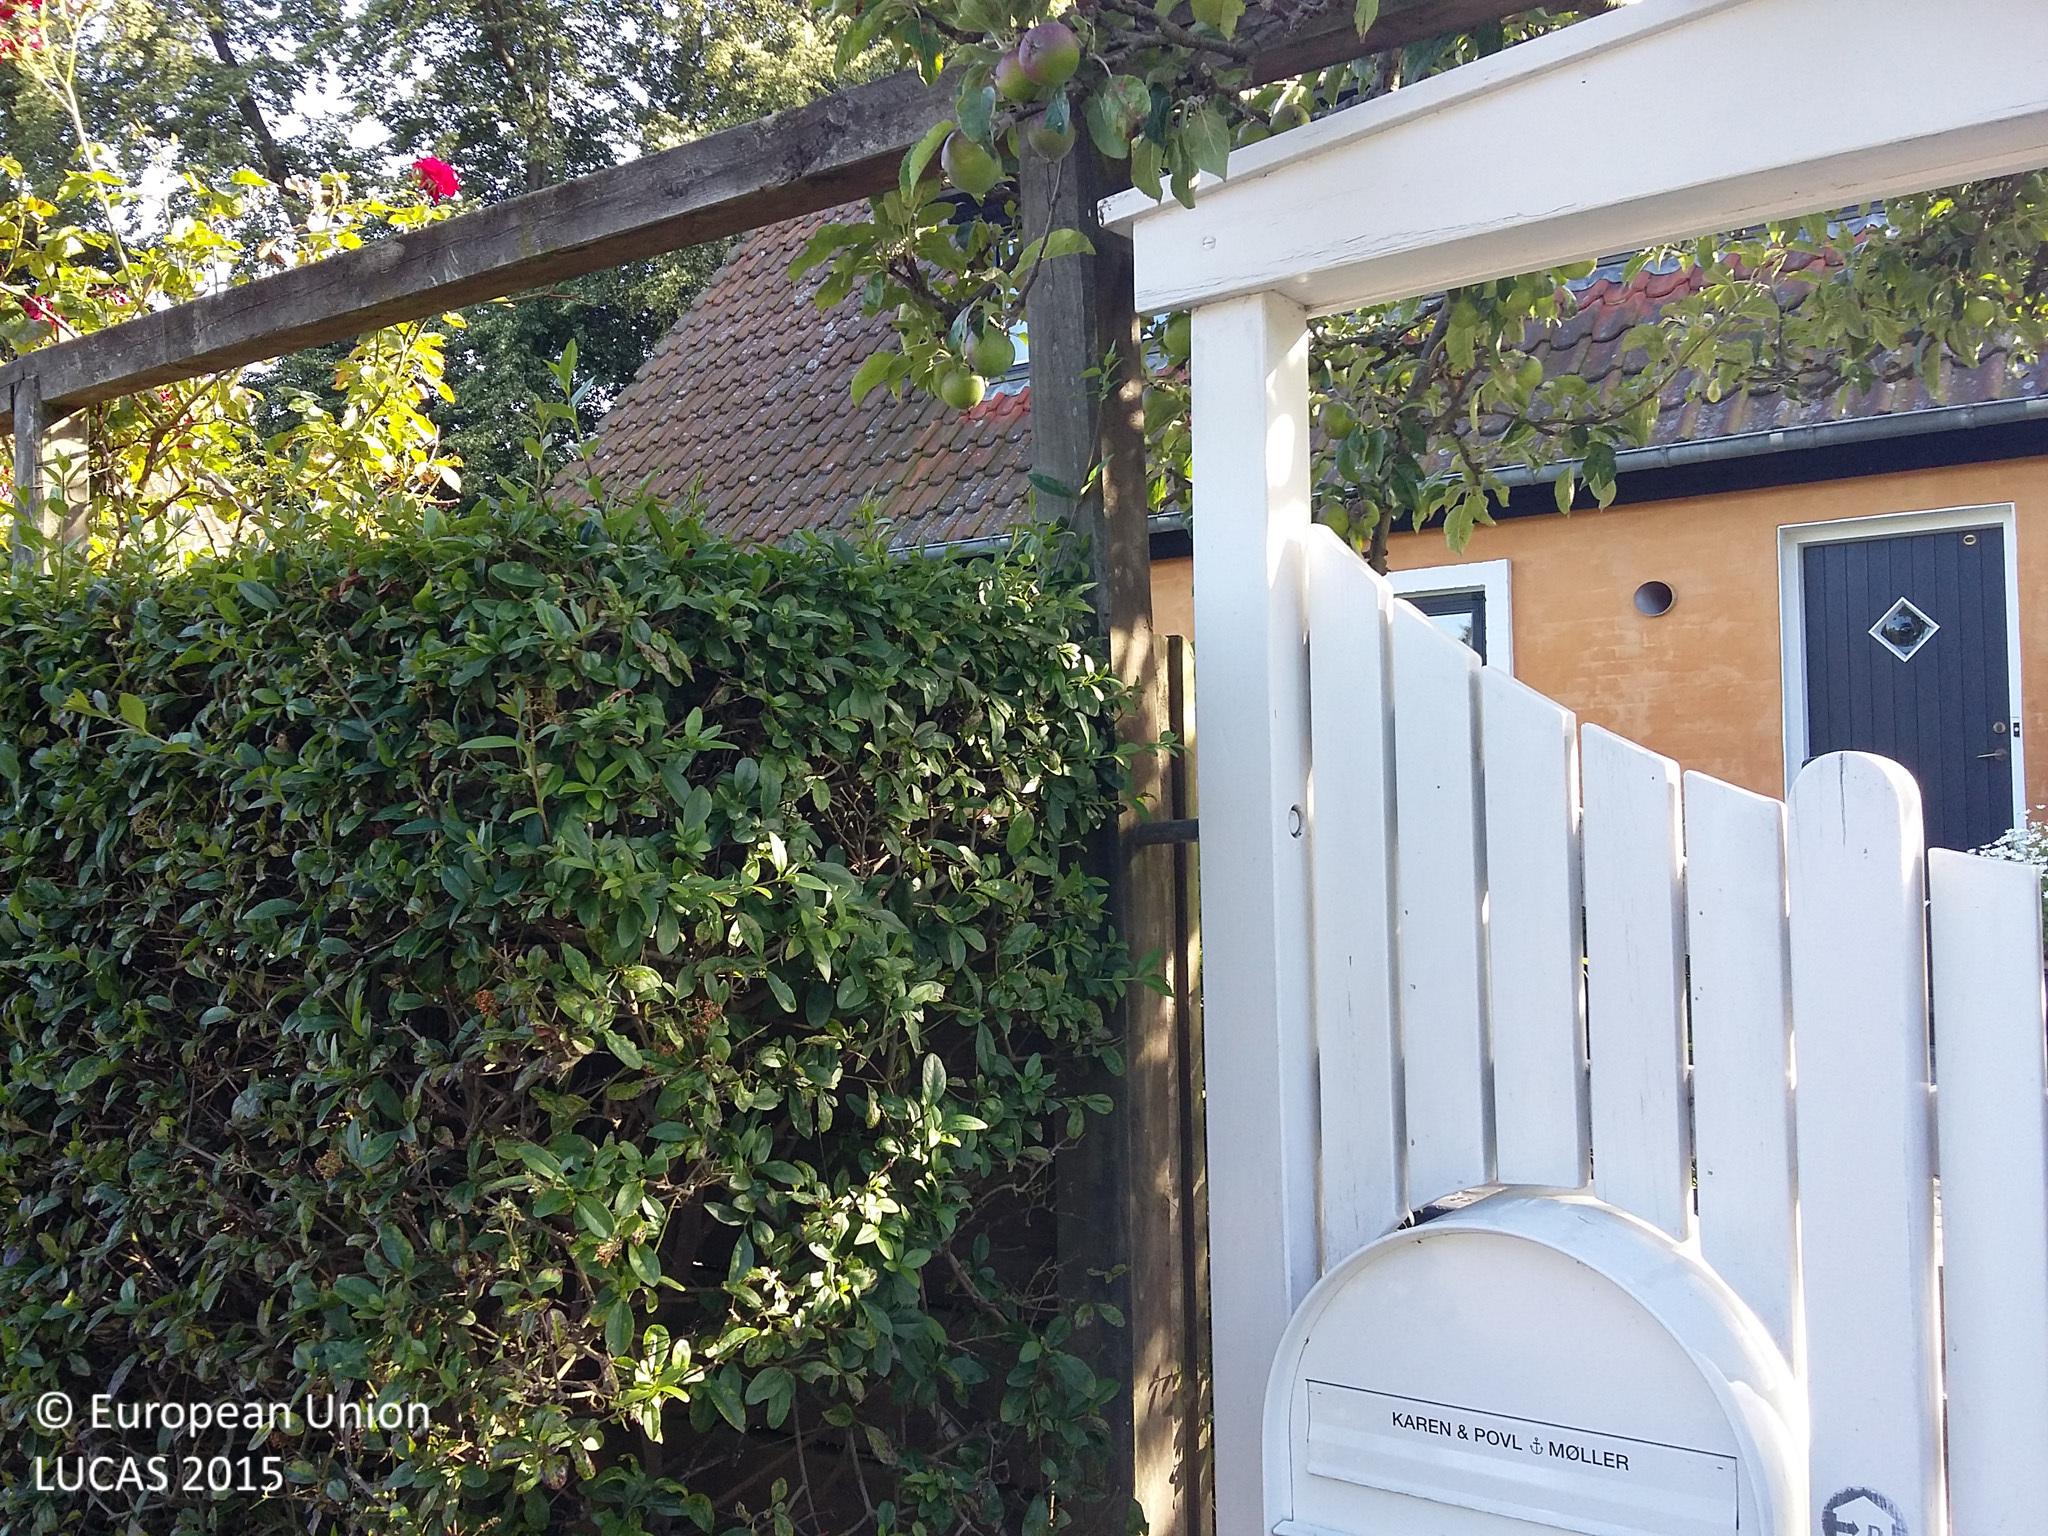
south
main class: Grassland
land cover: Grassland with sparse tree/shrub cover
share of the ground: > 75 %
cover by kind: herbaceous plants 85 %, shrubs 10 %, broadleaved forest trees 5 %
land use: Residential
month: July
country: DK
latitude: 56.0725
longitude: 12.5520
